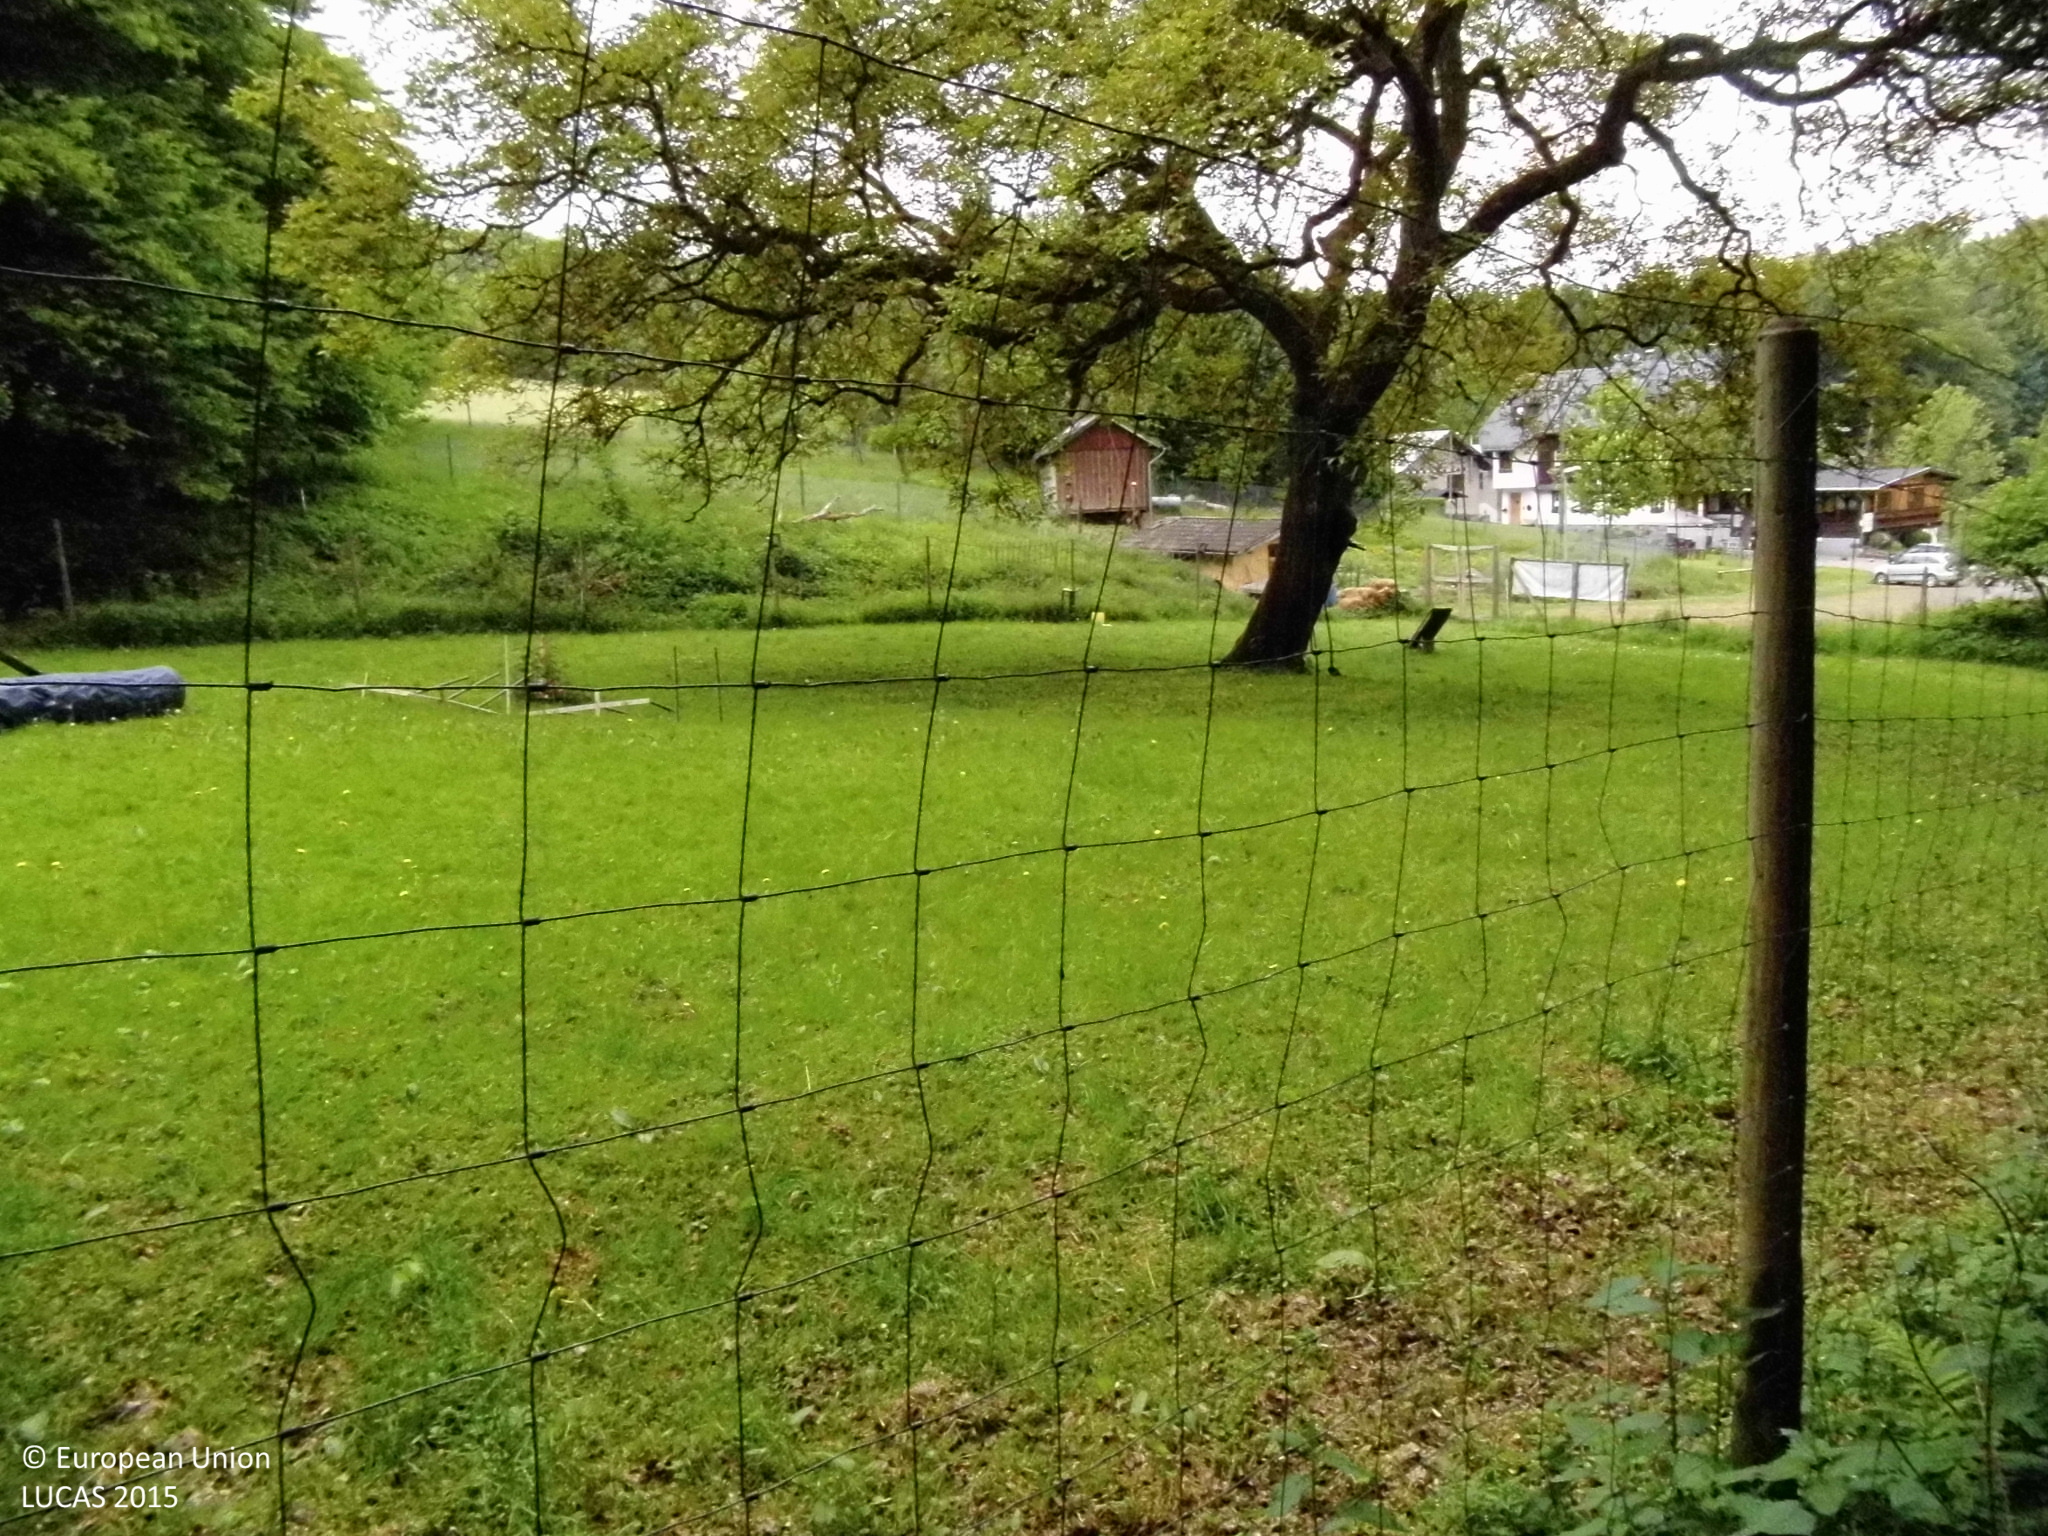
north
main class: Grassland
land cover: Grassland with sparse tree/shrub cover
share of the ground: > 75 %
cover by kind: herbaceous plants 95 %, broadleaved forest trees 5 %
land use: Amenities, museums, leisure
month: May
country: DE
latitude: 50.5712
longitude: 7.5293
